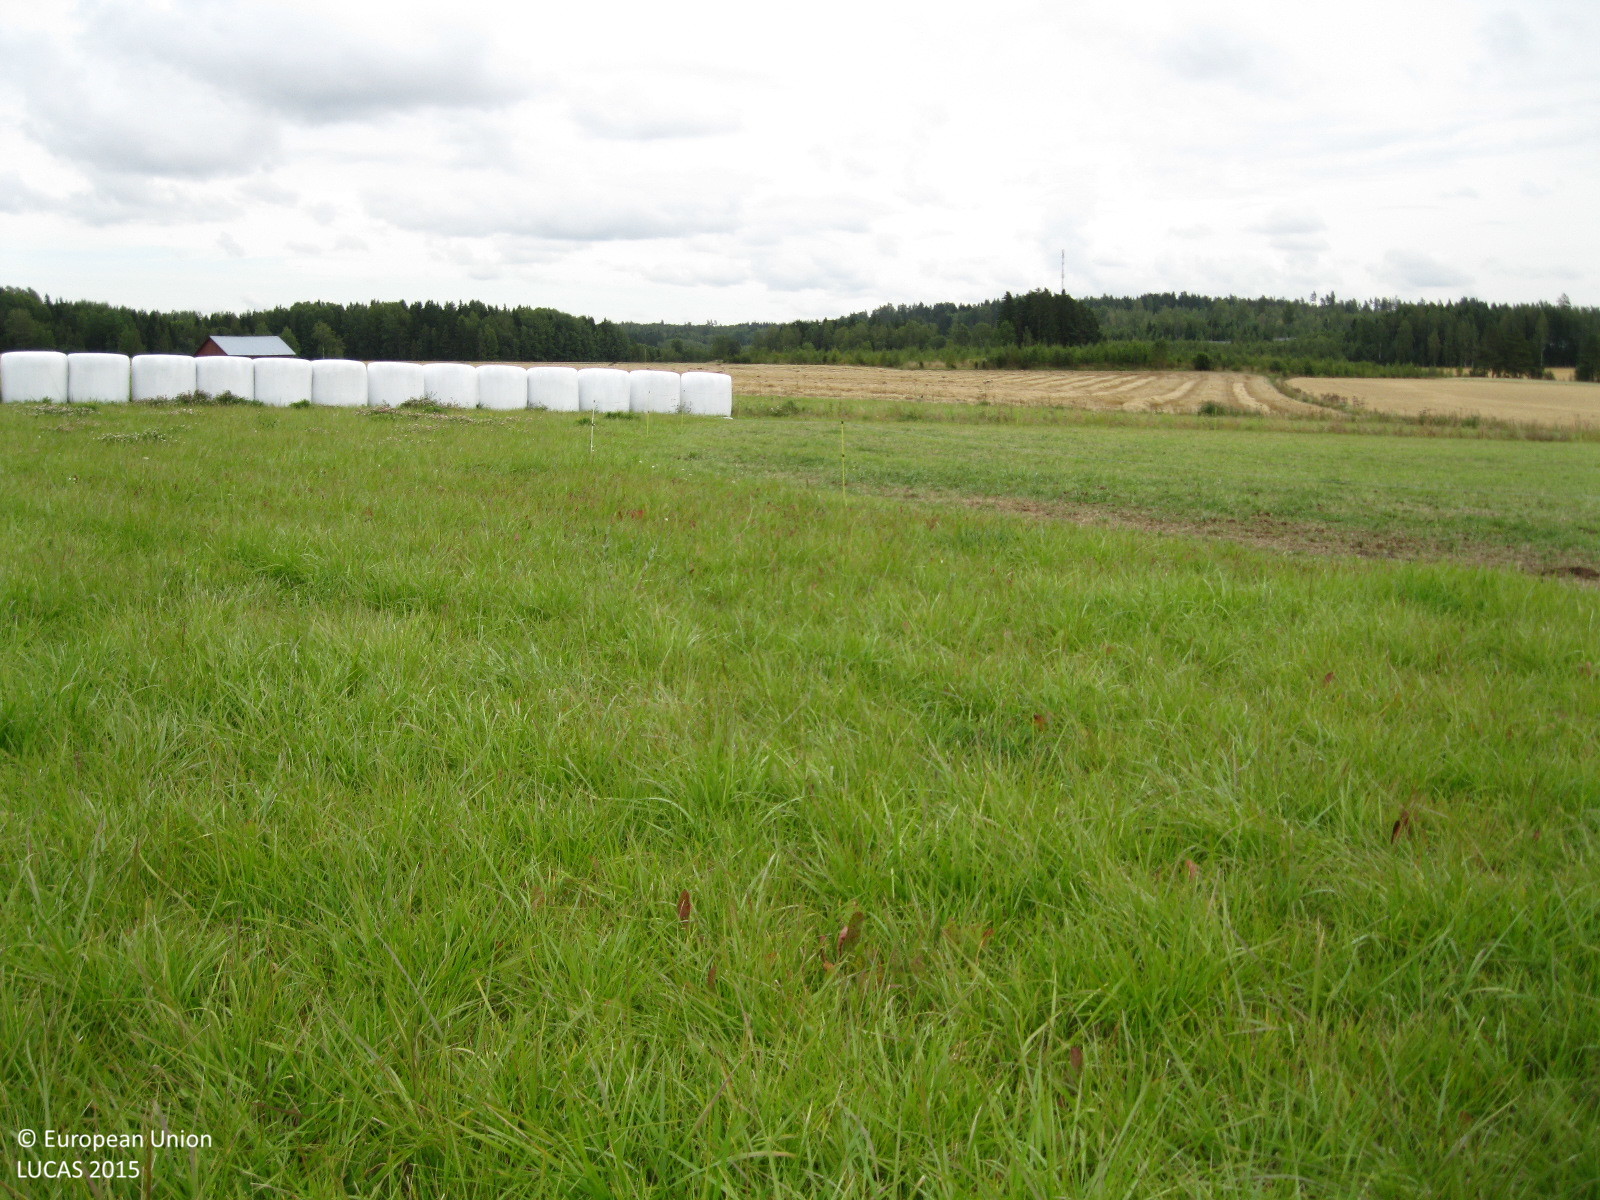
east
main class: Cropland
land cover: Temporary grasslands
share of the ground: > 75 %
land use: Agriculture (excluding fallow land and kitchen gardens)
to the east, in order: Temporary grasslands; Fences; Grassland without tree/shrub cover; Fences; Grass margins; Ditches and canals; Grass margins; Temporary grasslands; Grass margins; Ditches and canals; Grass margins; Common wheat
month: September
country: FI
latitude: 60.4040
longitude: 24.7984
